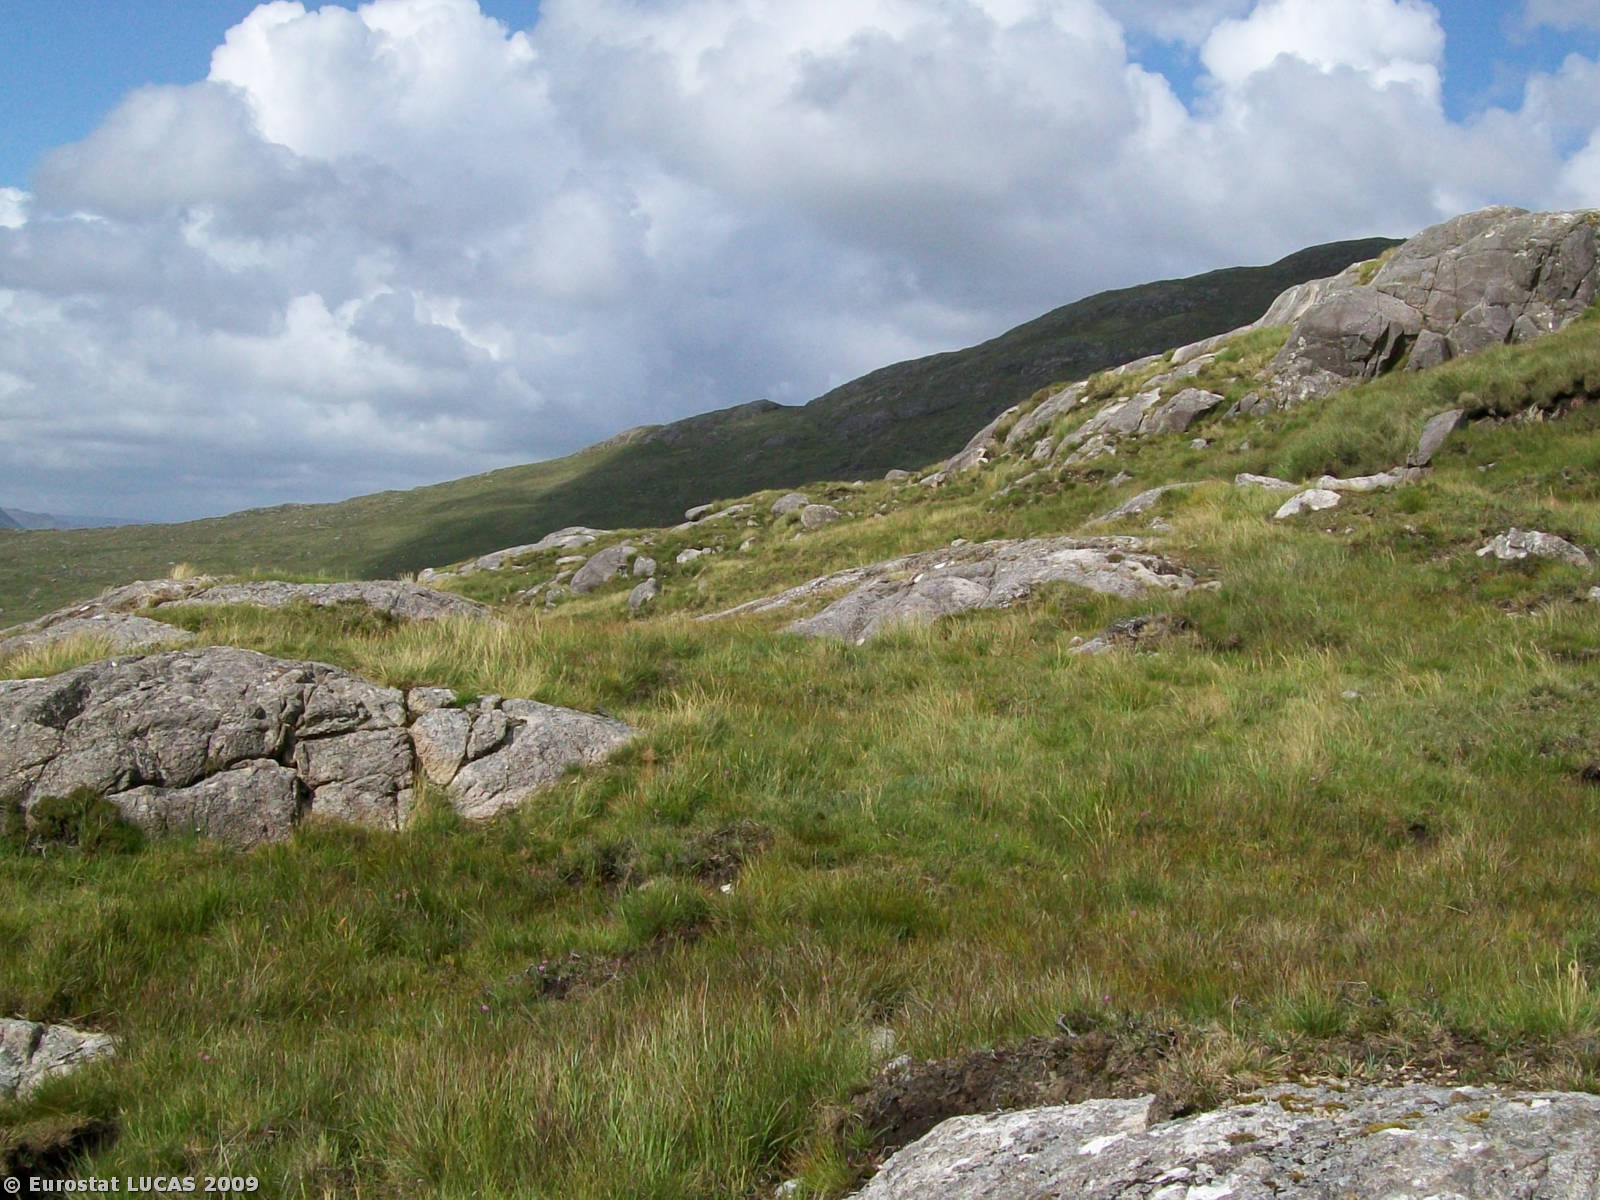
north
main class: Grassland
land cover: Grassland without tree/shrub cover
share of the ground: > 75 %
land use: Nature reserves
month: August
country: IE
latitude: 53.3884
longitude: -9.4935
